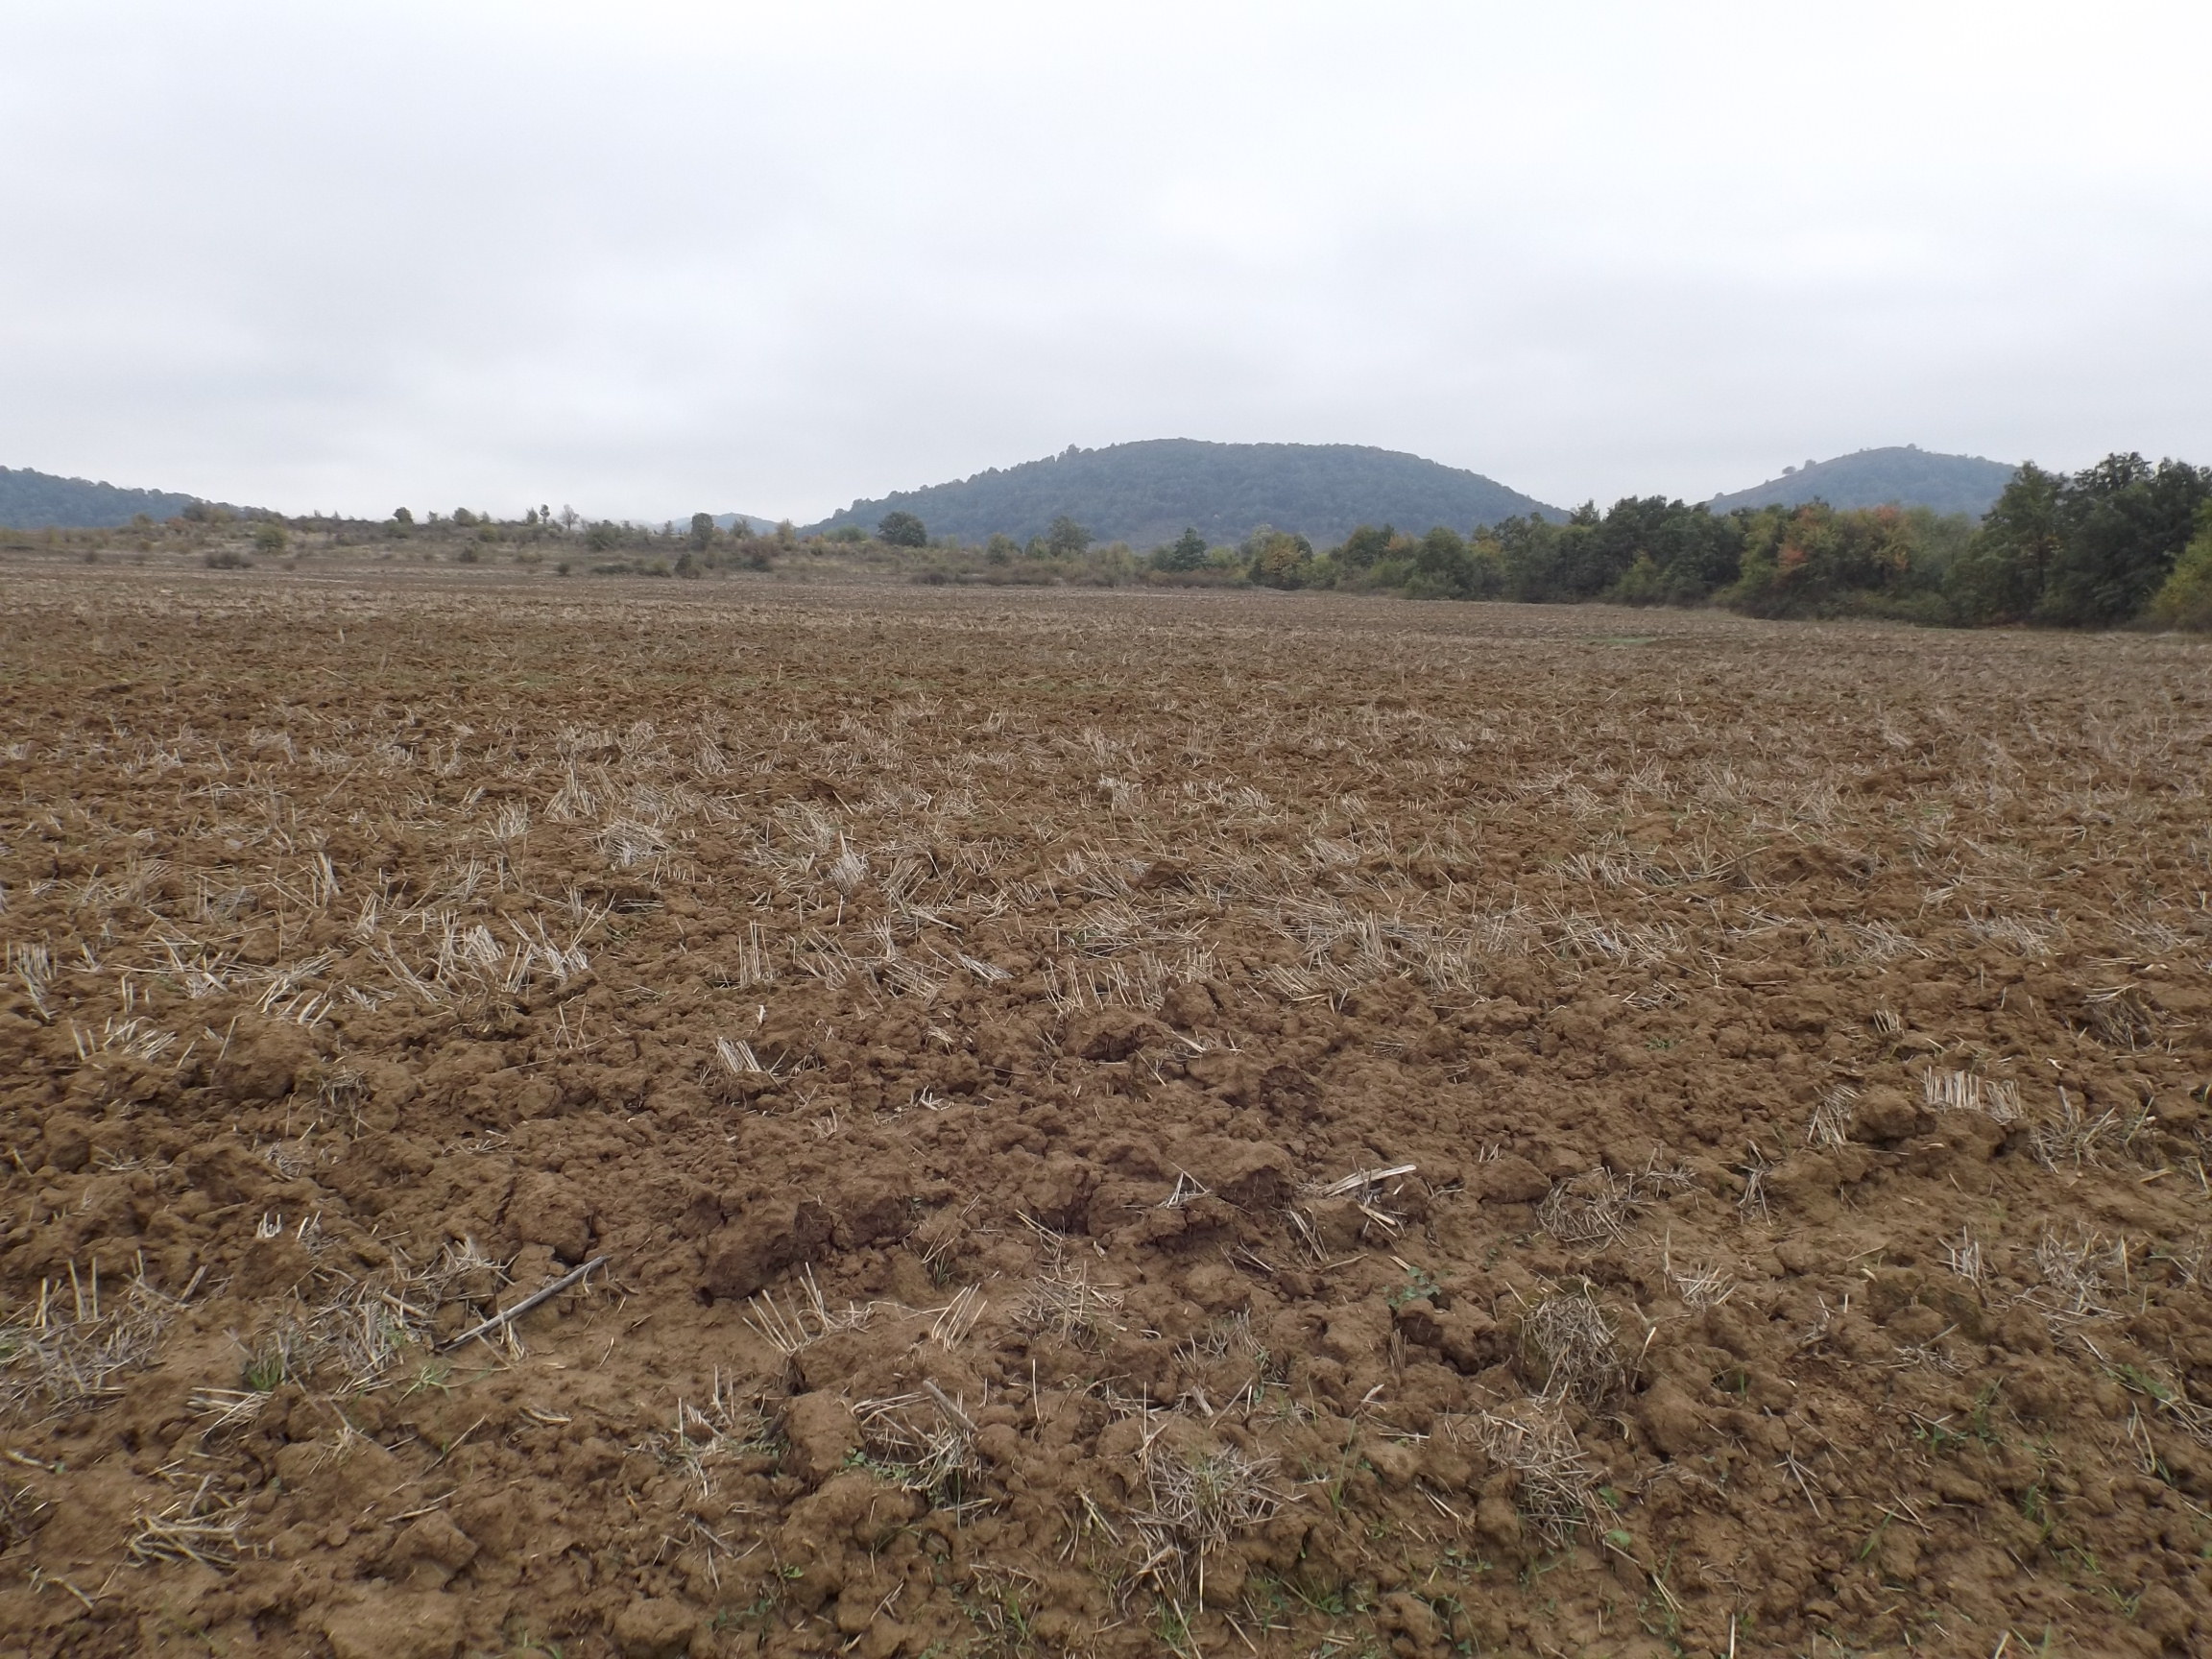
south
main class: Cropland
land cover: Common wheat
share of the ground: < 10 %
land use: Agriculture (excluding fallow land and kitchen gardens)
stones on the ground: < 10 %
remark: Harvested field
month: October
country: BG
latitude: 42.9835
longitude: 27.1488
